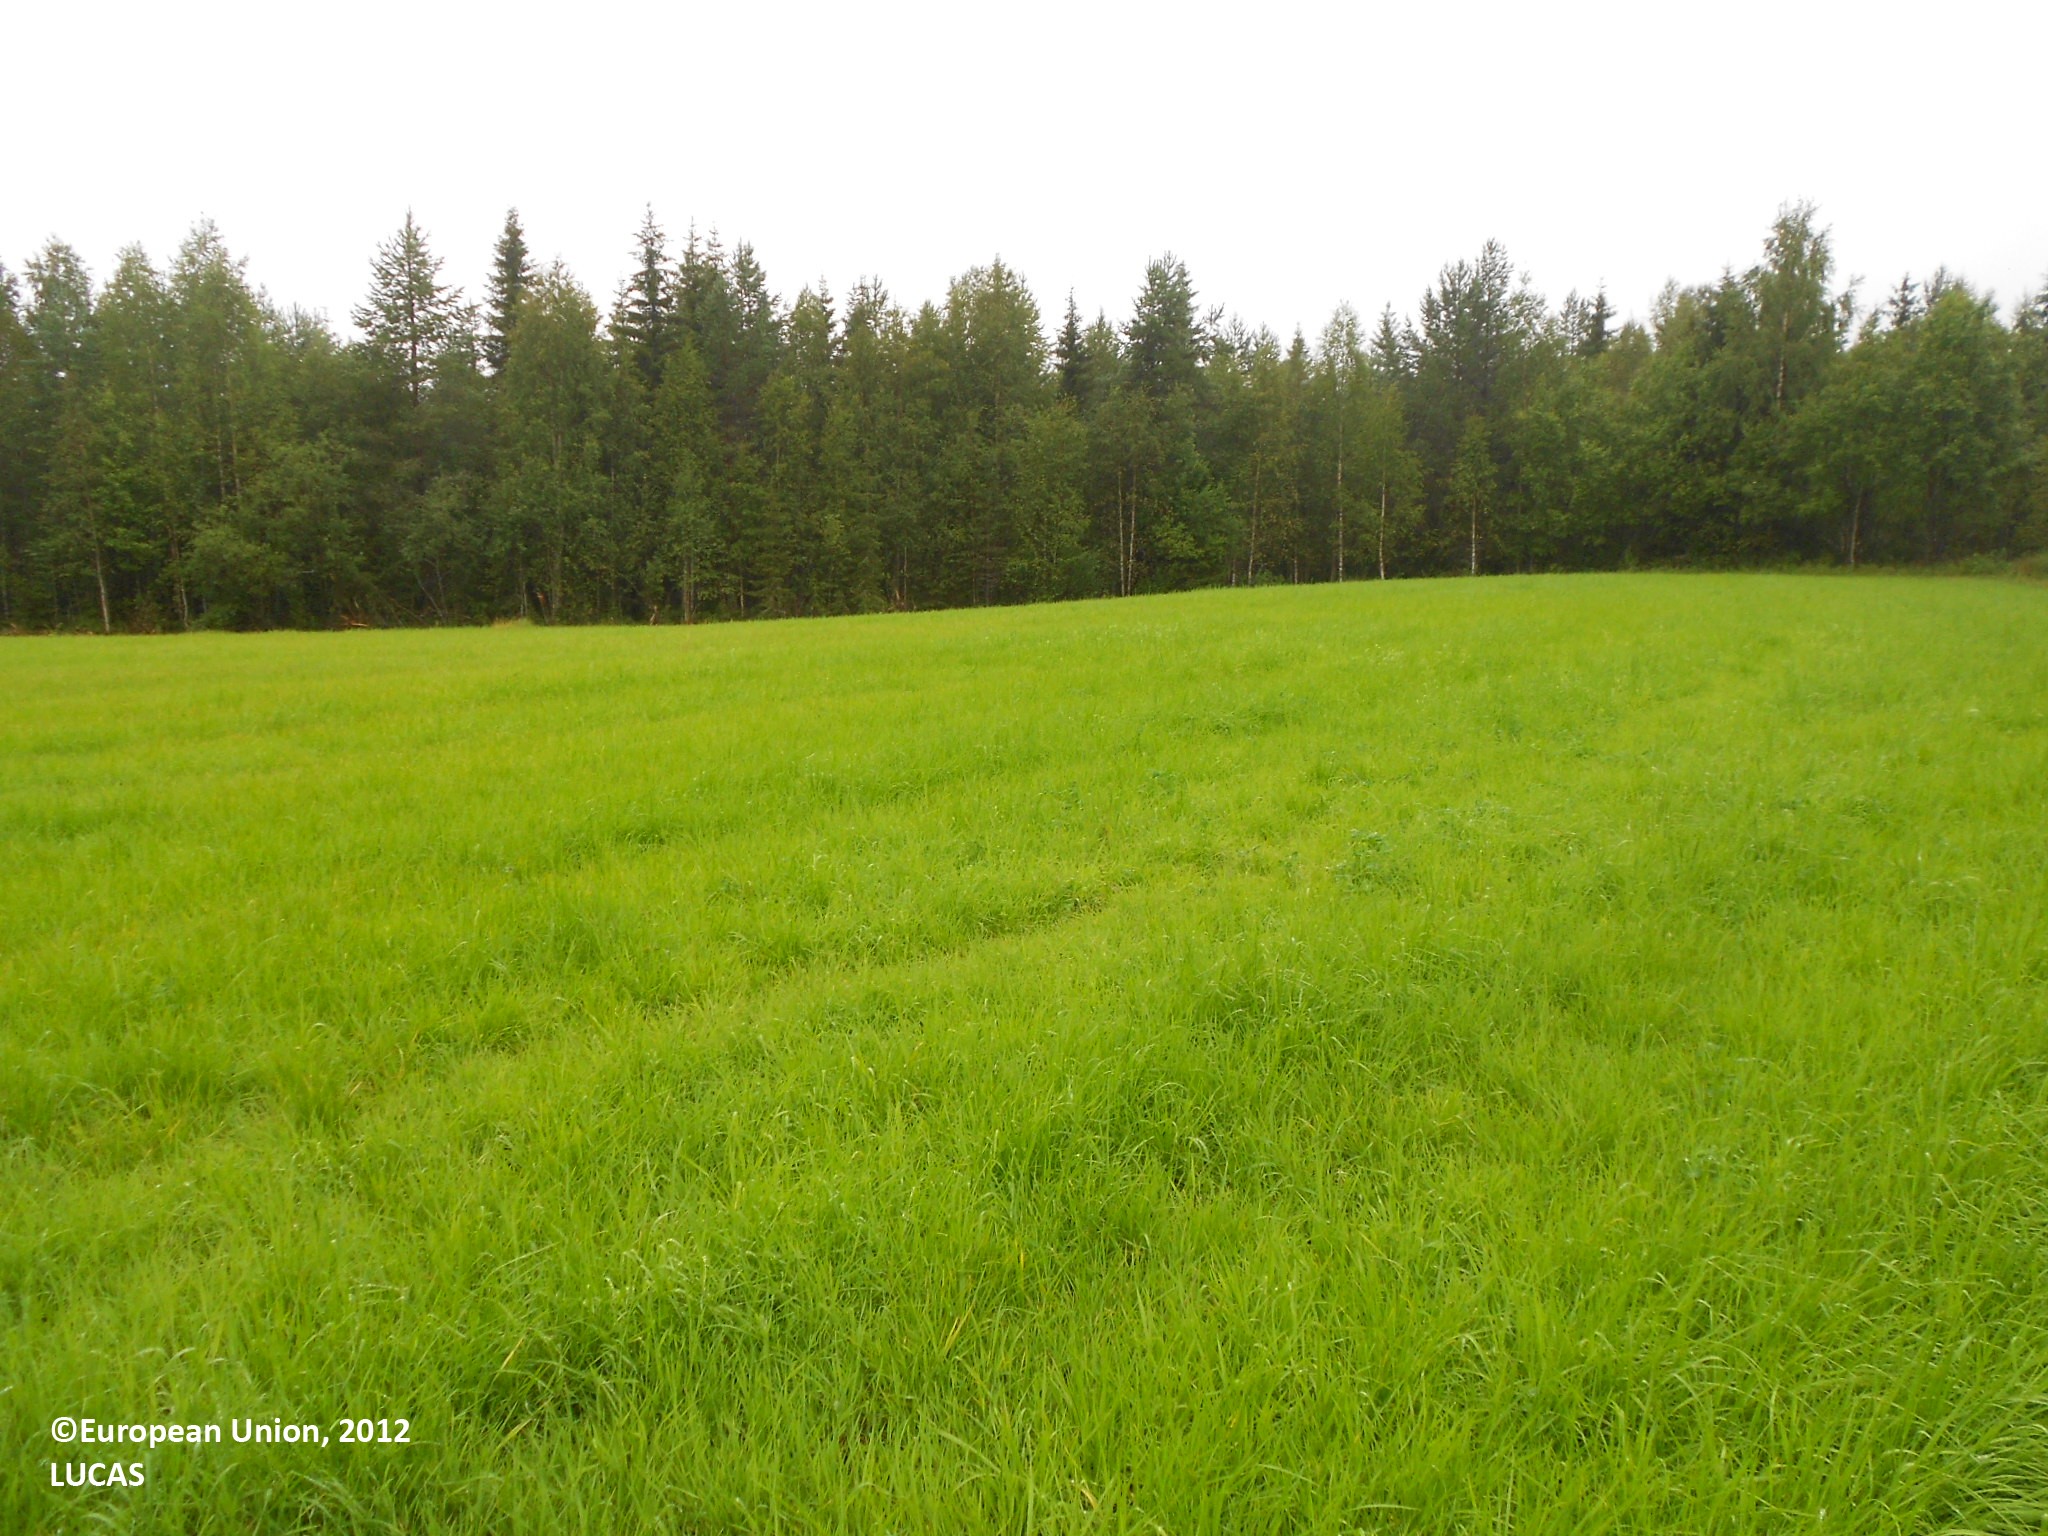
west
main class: Cropland
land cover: Temporary grasslands
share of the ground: > 75 %
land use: Agriculture (excluding fallow land and kitchen gardens)
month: August
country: FI
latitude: 63.9943
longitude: 28.2656
